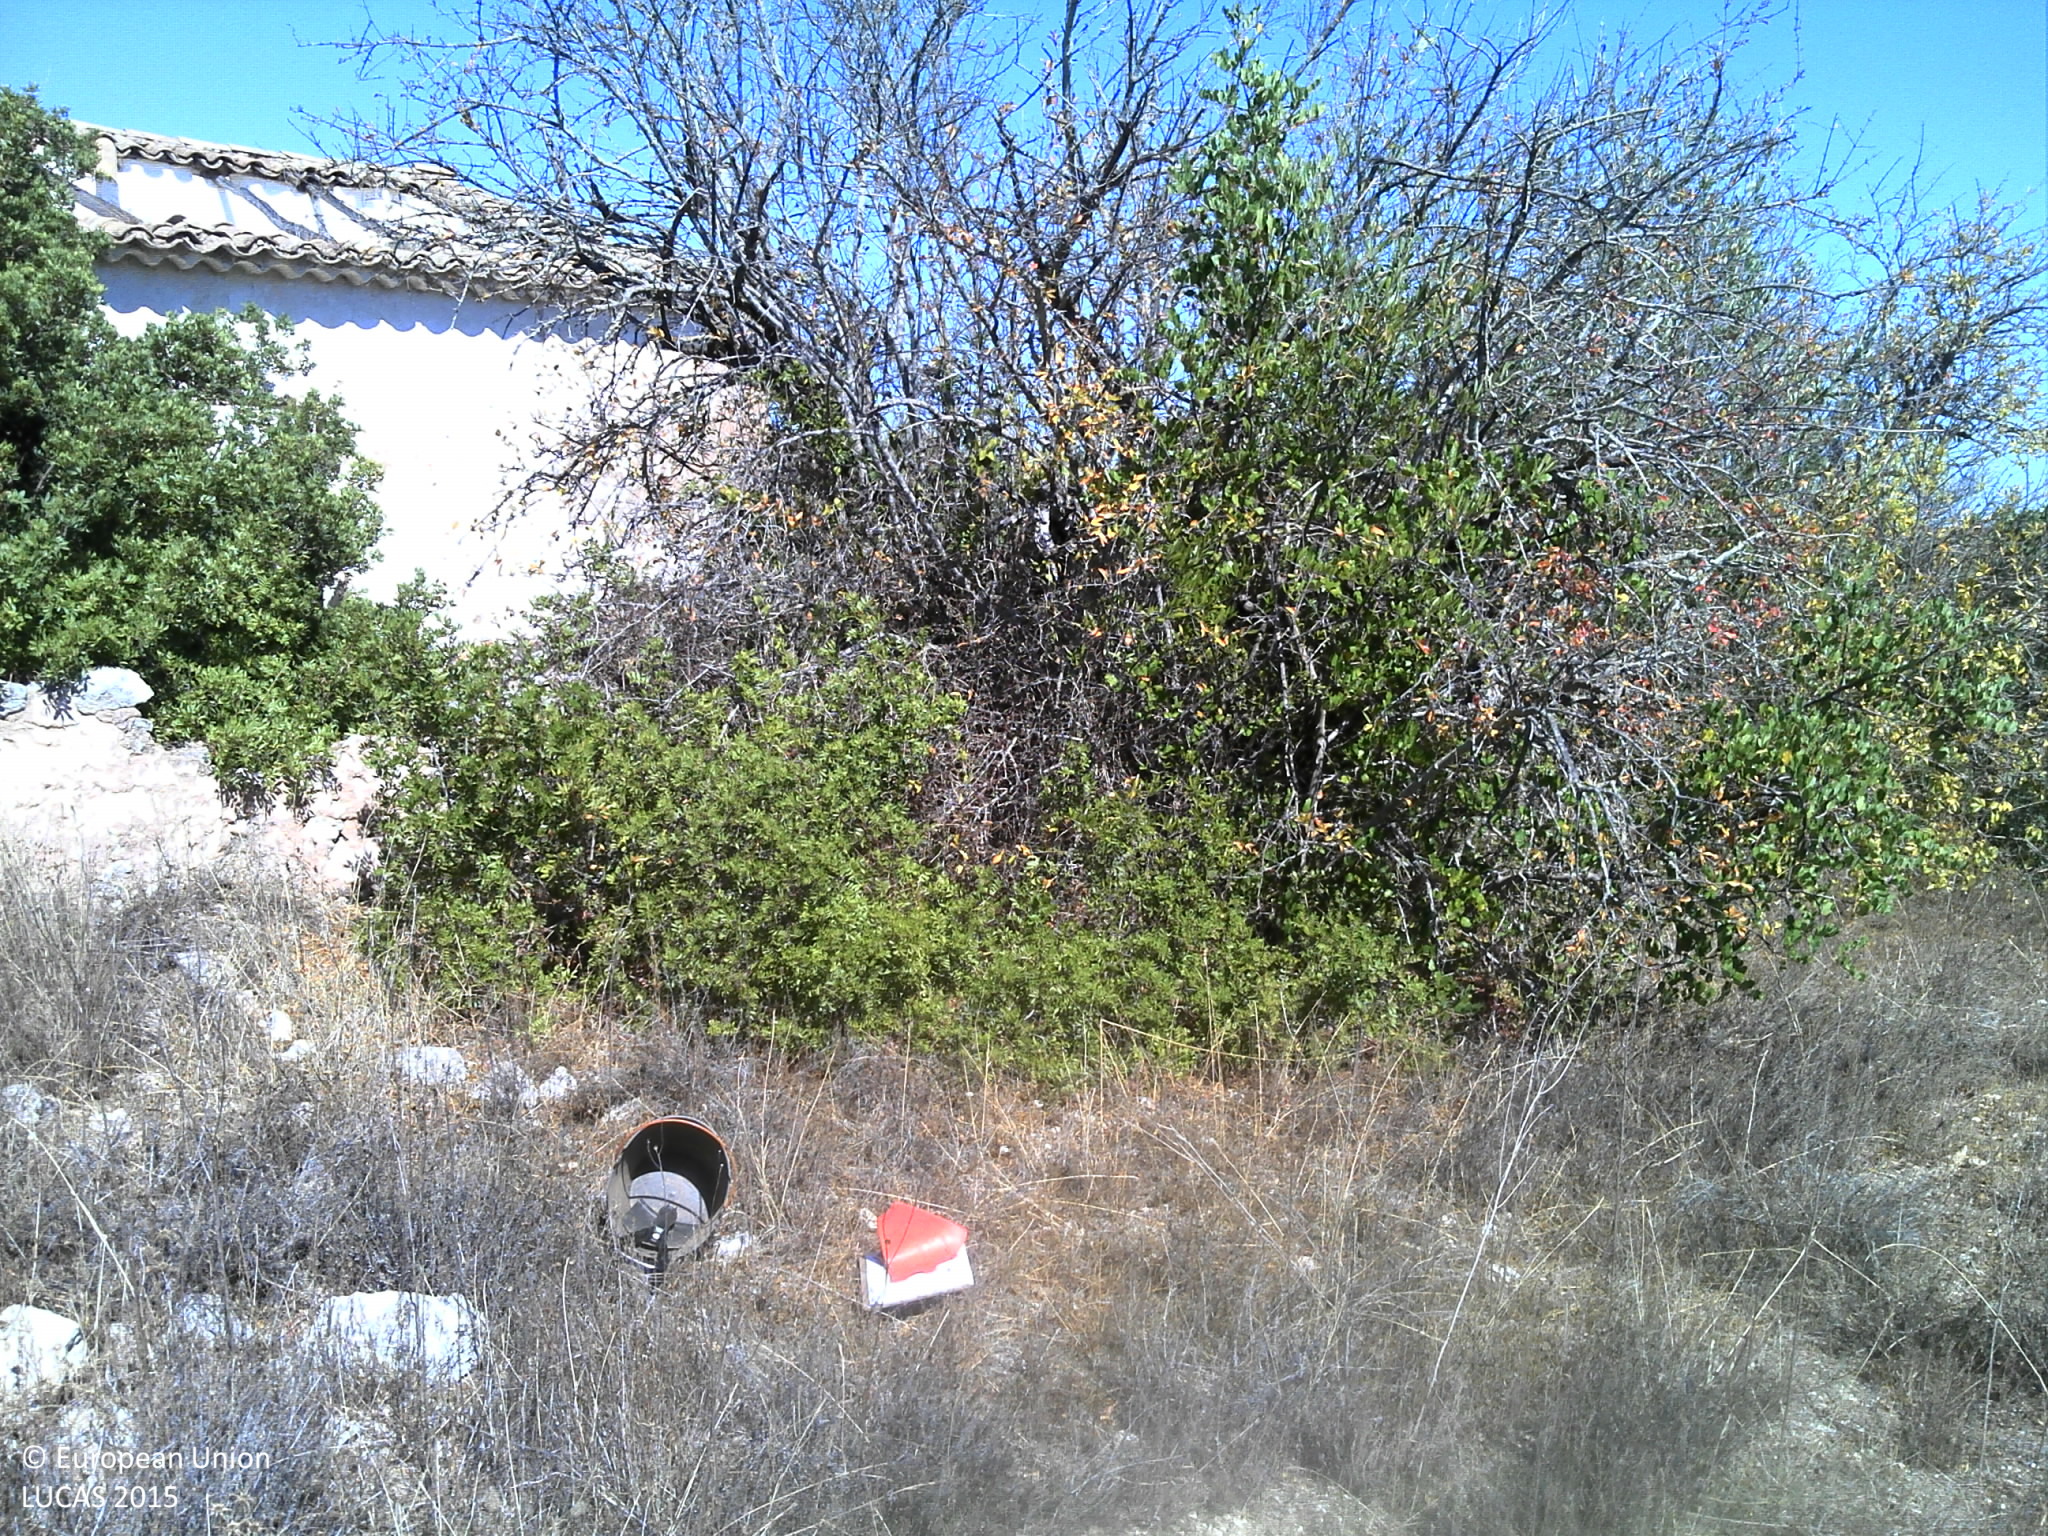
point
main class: Cropland
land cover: Other fruit trees and berries
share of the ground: 25 - 50 %
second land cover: Grassland without tree/shrub cover
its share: 25 - 50 %
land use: Agriculture (excluding fallow land and kitchen gardens)
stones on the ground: < 10 %
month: September
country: PT
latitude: 37.1510
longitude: -8.1553
